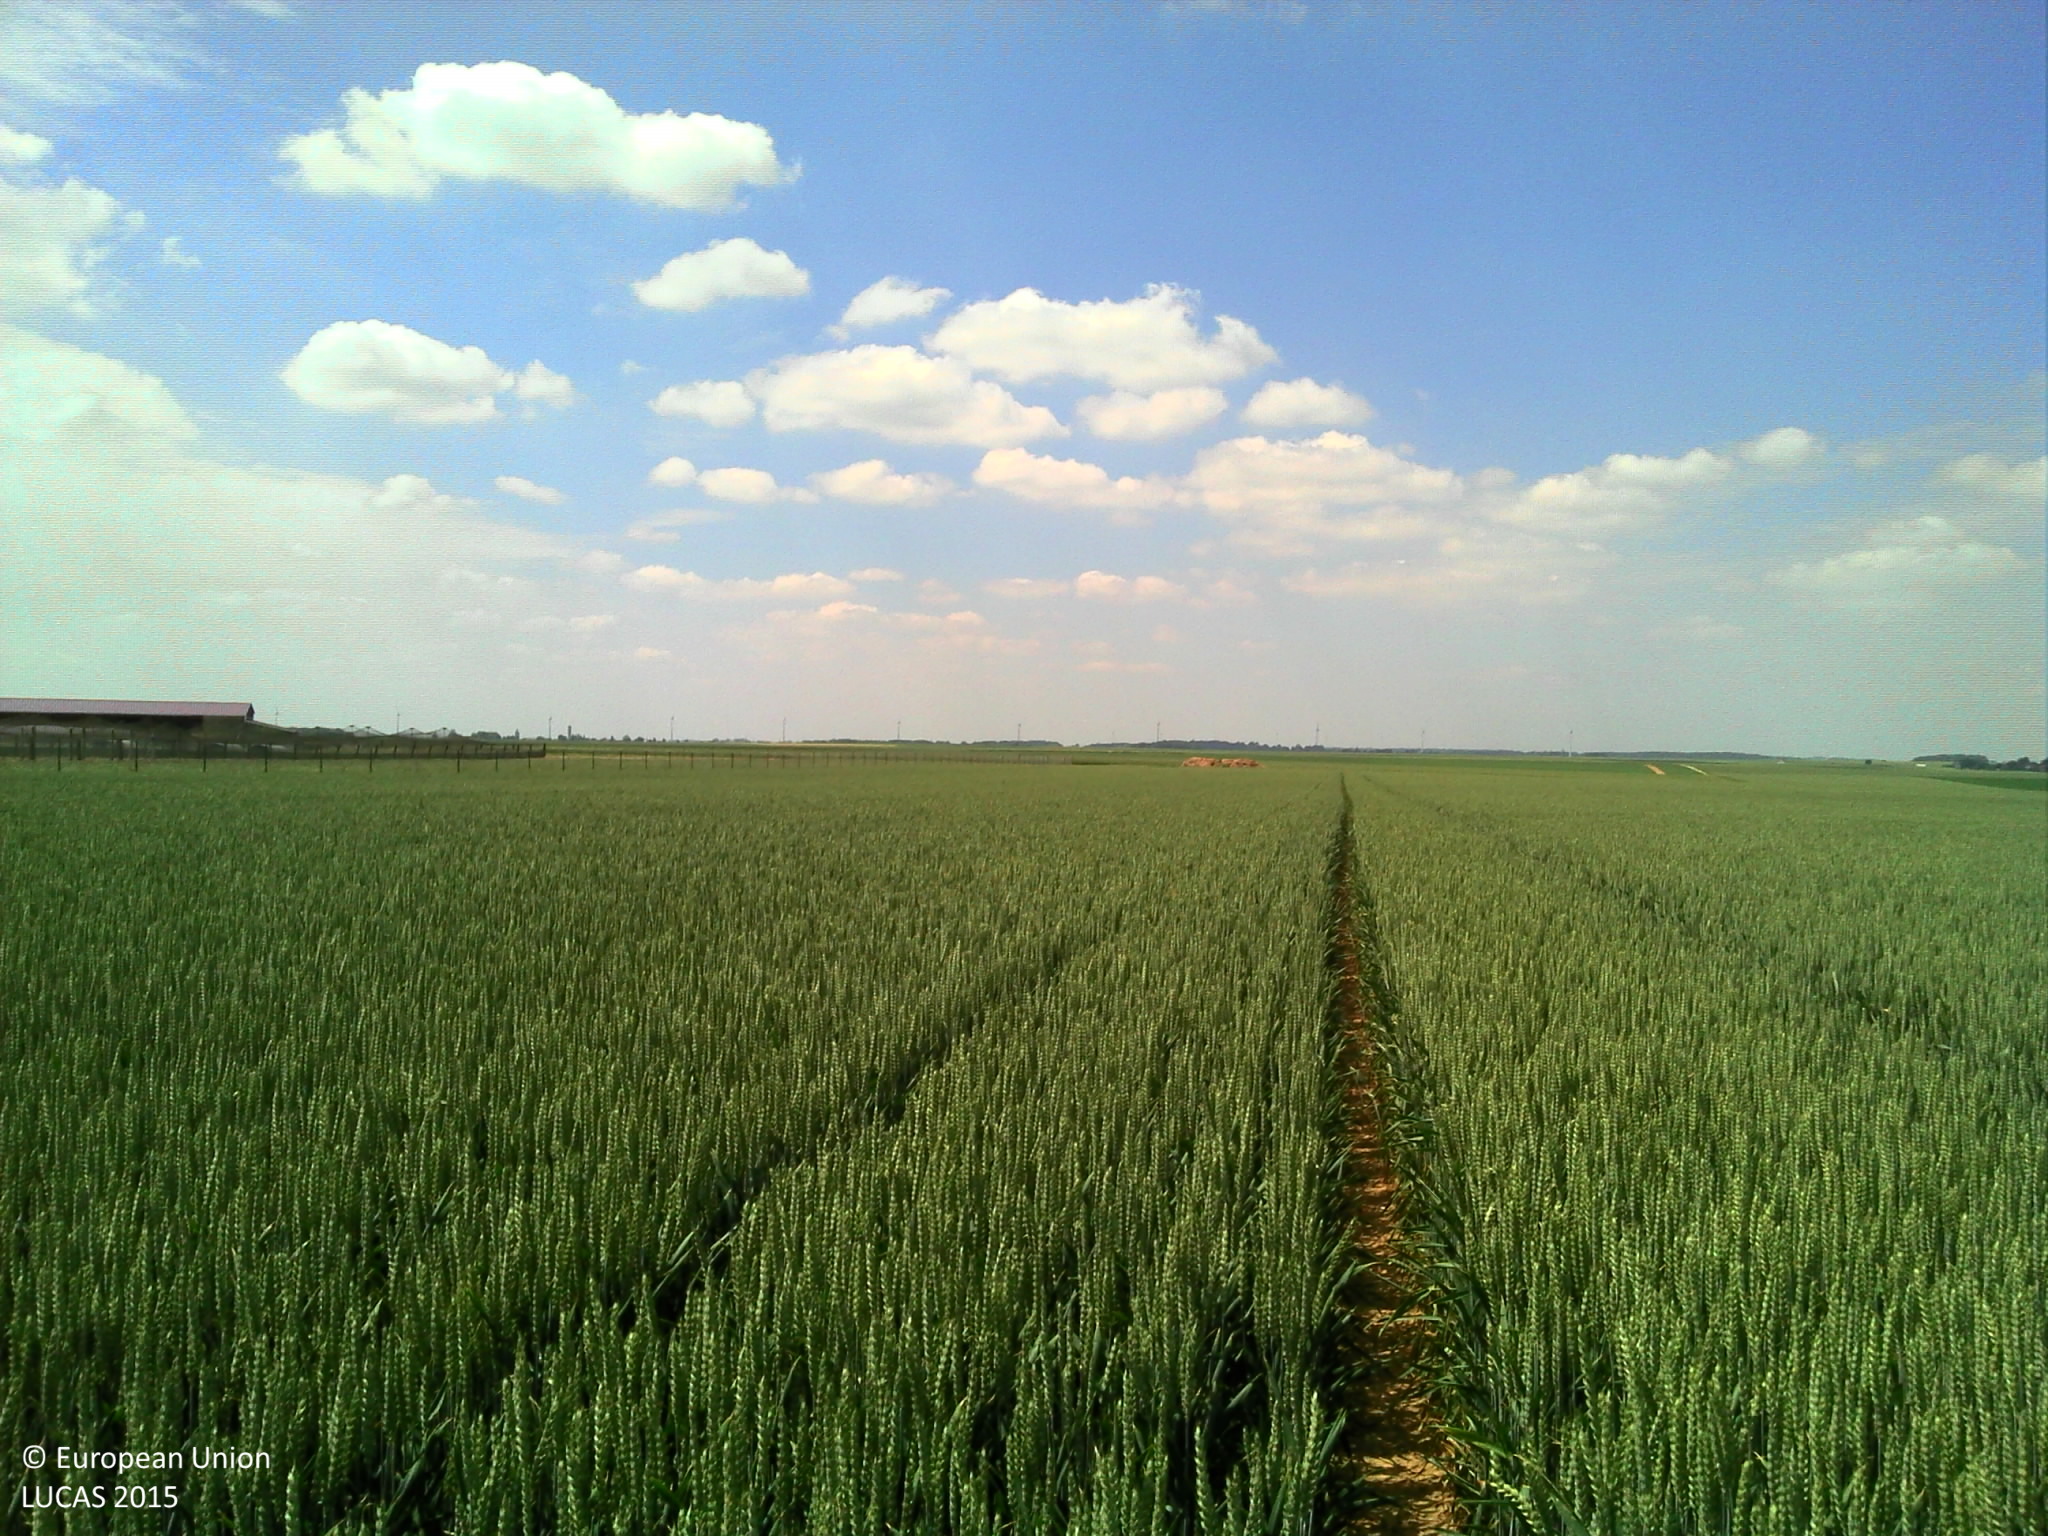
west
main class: Cropland
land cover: Common wheat
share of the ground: > 75 %
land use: Agriculture (excluding fallow land and kitchen gardens)
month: June
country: FR
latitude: 49.5583
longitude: 2.5089
